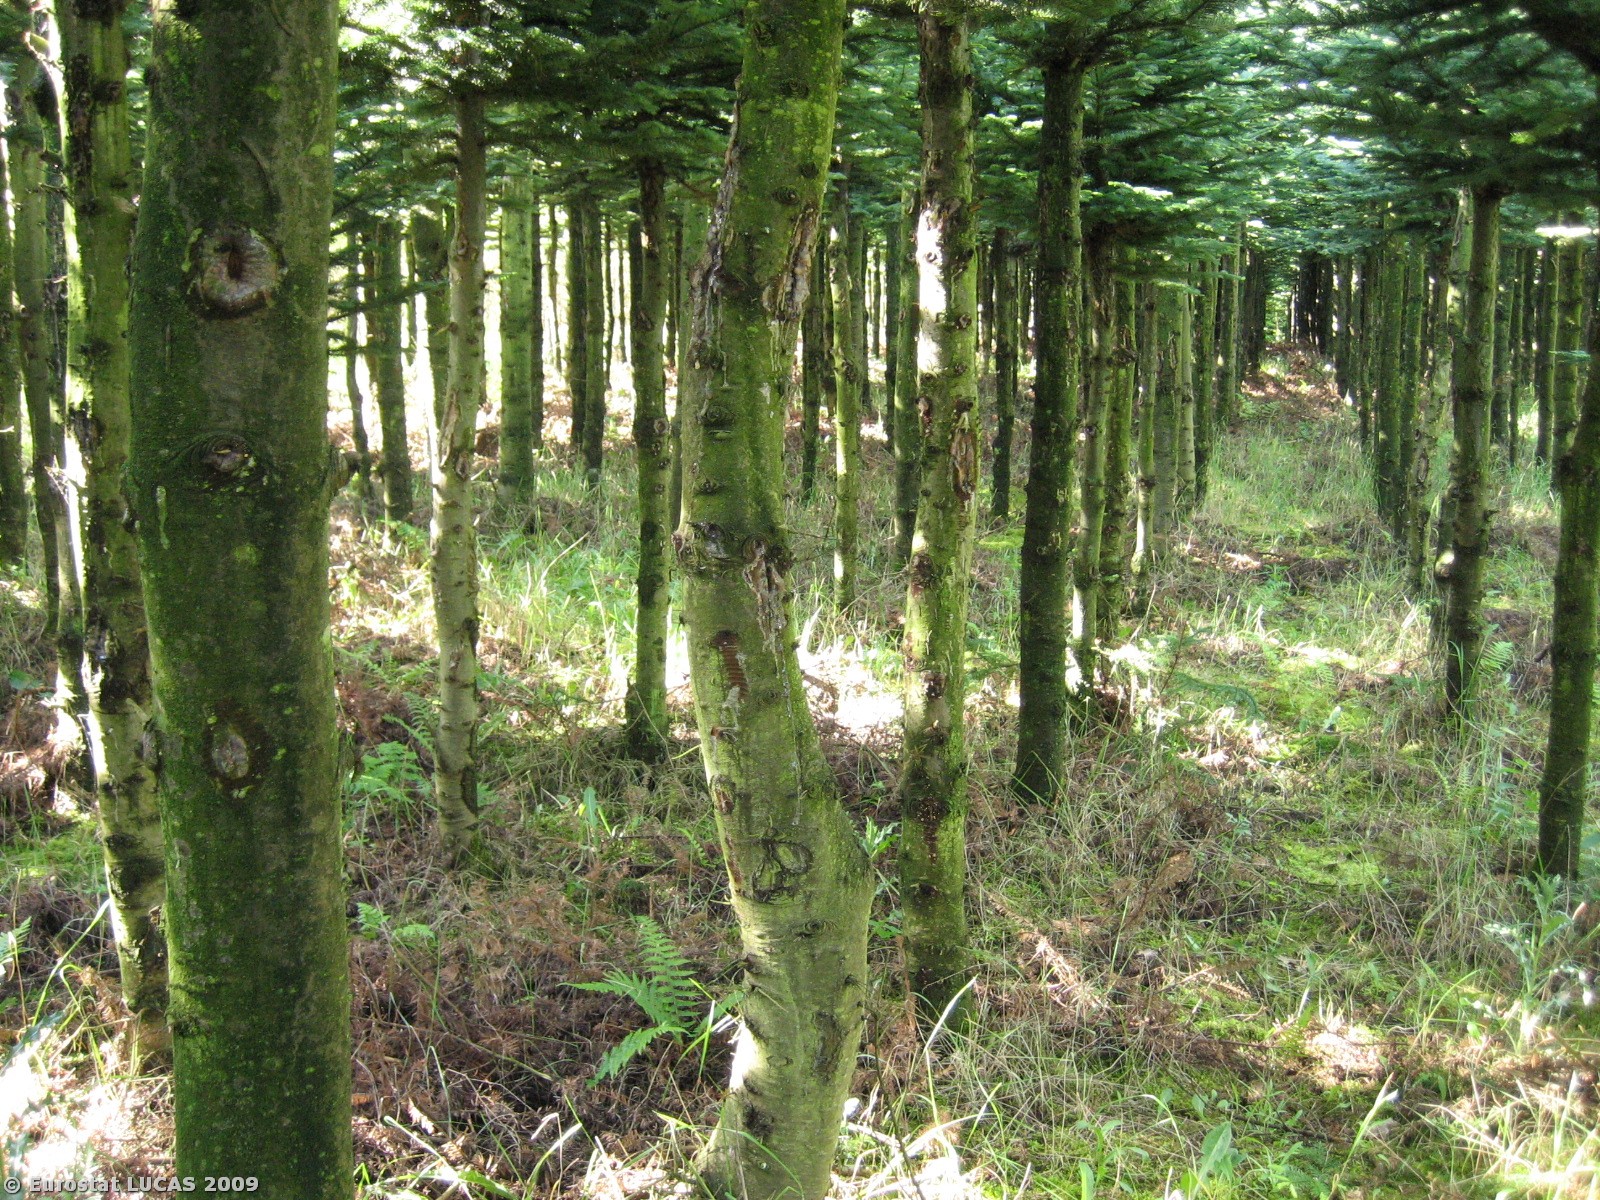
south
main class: Woodland
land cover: Coniferous woodland
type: hemiboreal forest and nemoral coniferous forest and mixed broadleaved-coniferous forest
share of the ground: > 75 %
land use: Forestry
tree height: > 5 m
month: May
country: DK
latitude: 55.8801
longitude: 9.2814
